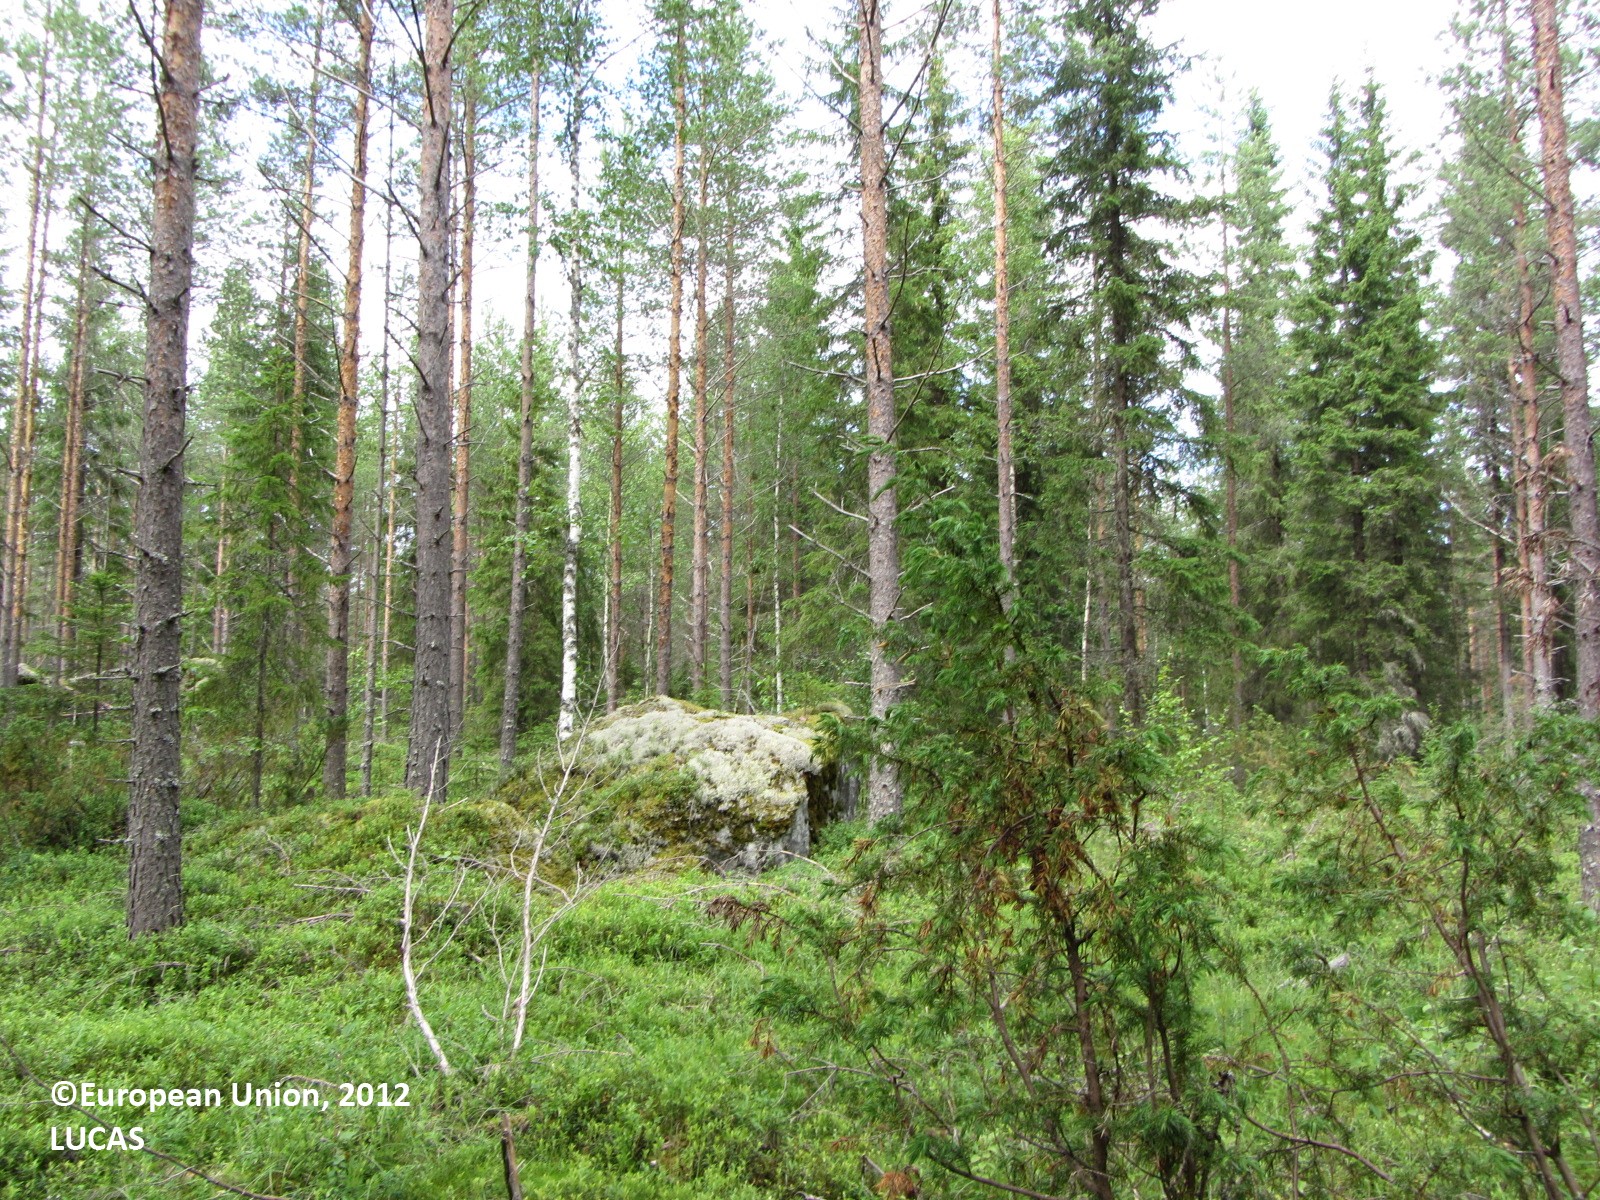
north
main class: Woodland
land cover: Other coniferous woodland
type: boreal forest
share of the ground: > 75 %
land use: Forestry
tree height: > 5 m
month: July
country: FI
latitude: 63.6945
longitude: 25.4078
